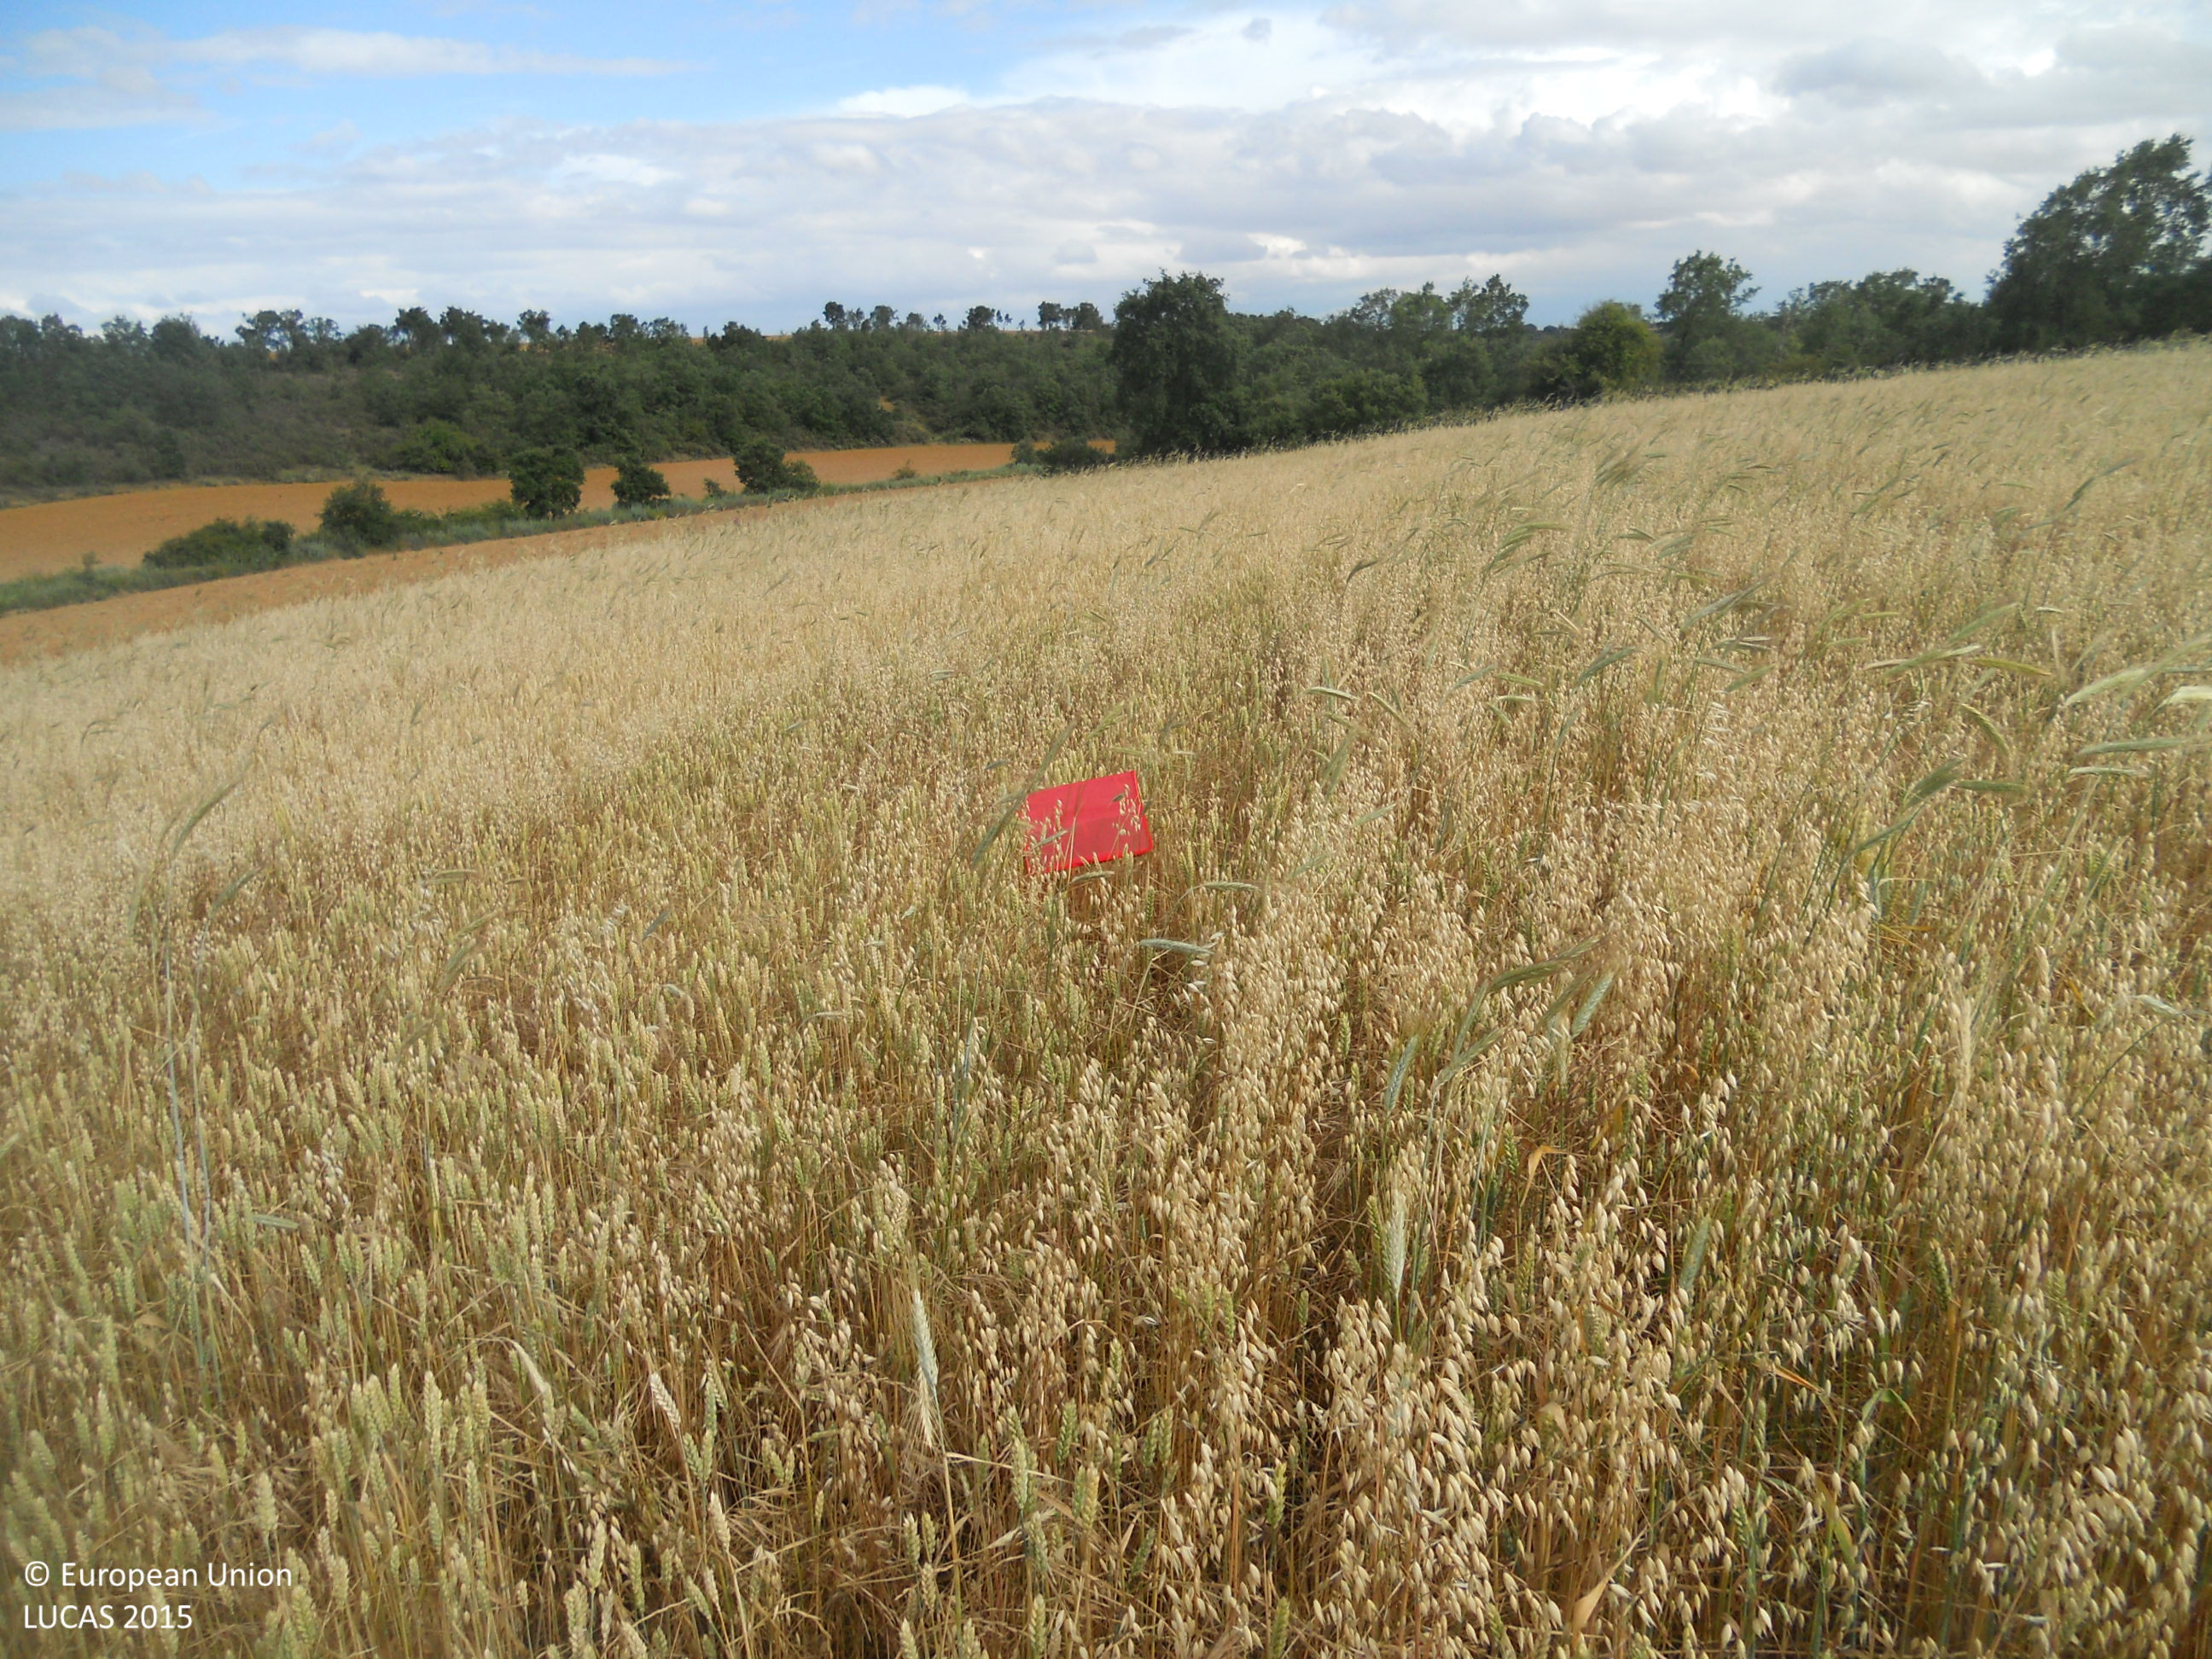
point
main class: Cropland
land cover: Mixed cereals for fodder
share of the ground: > 75 %
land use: Agriculture (excluding fallow land and kitchen gardens)
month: June
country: ES
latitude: 42.3404
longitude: -4.8514
